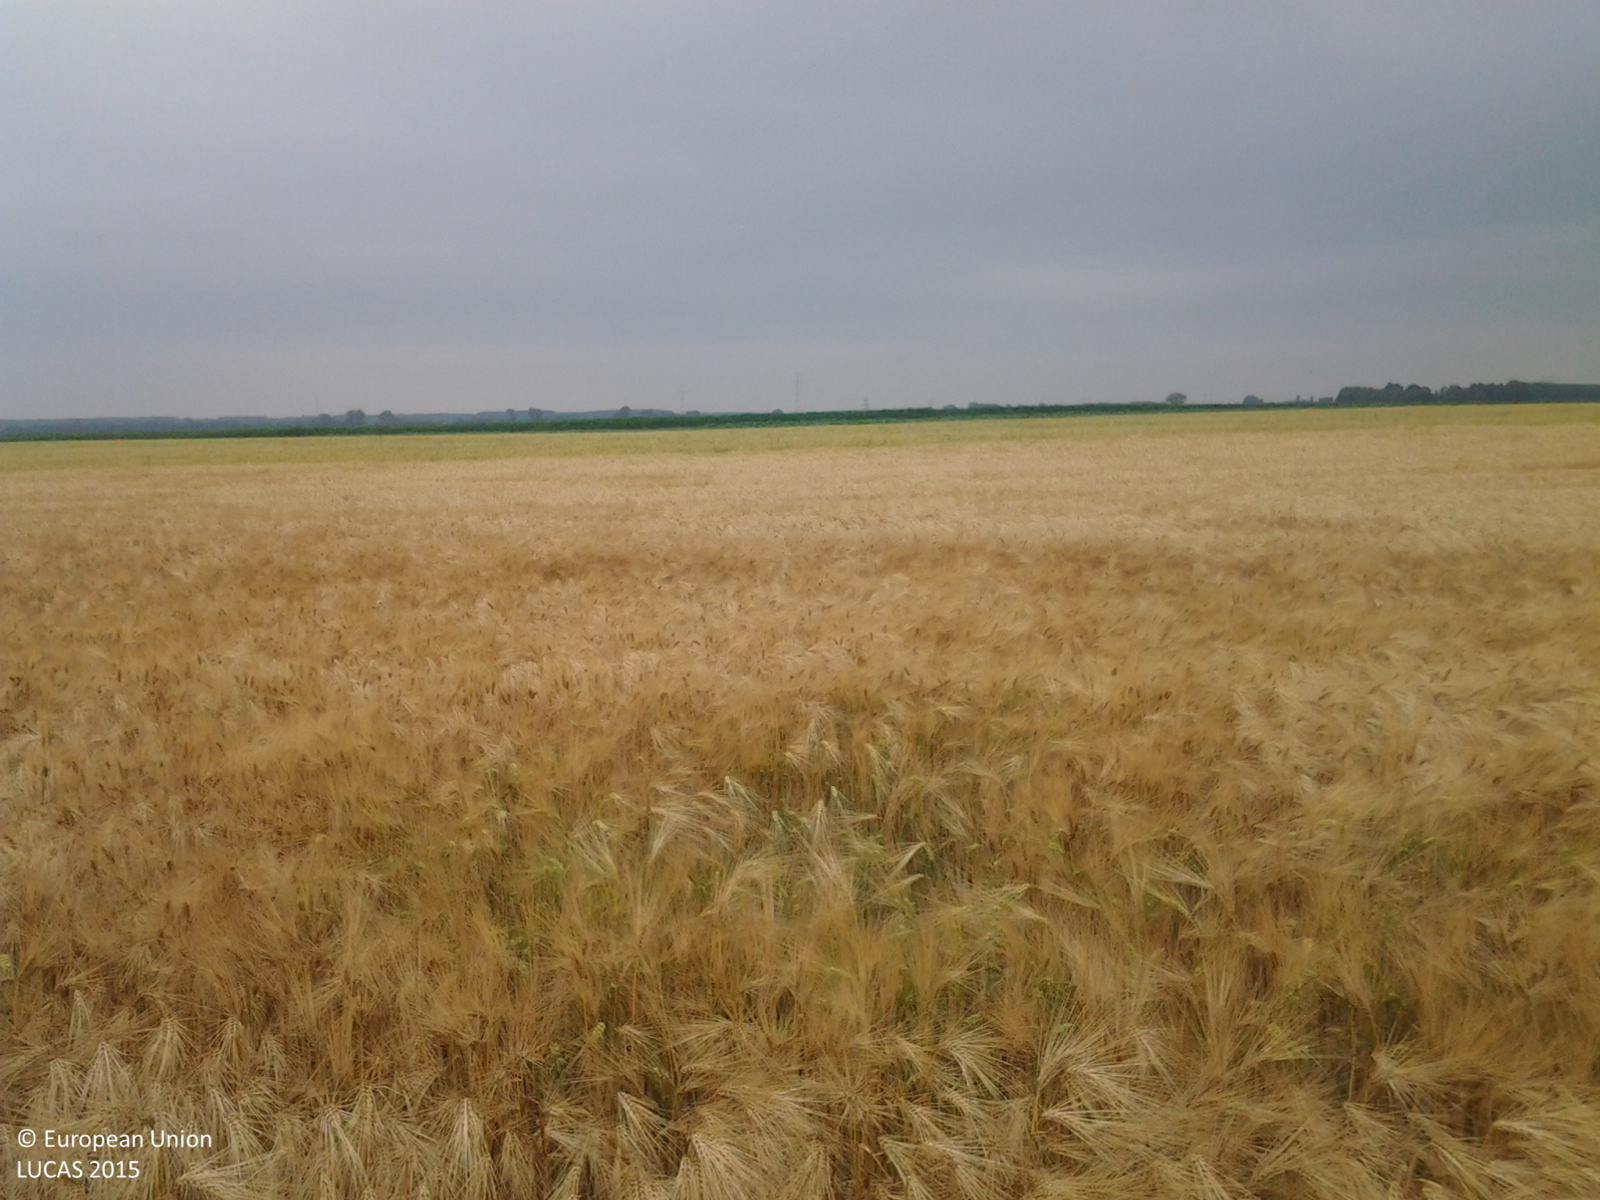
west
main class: Cropland
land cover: Barley
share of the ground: > 75 %
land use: Agriculture (excluding fallow land and kitchen gardens)
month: June
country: HU
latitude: 46.4616
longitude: 18.9849
